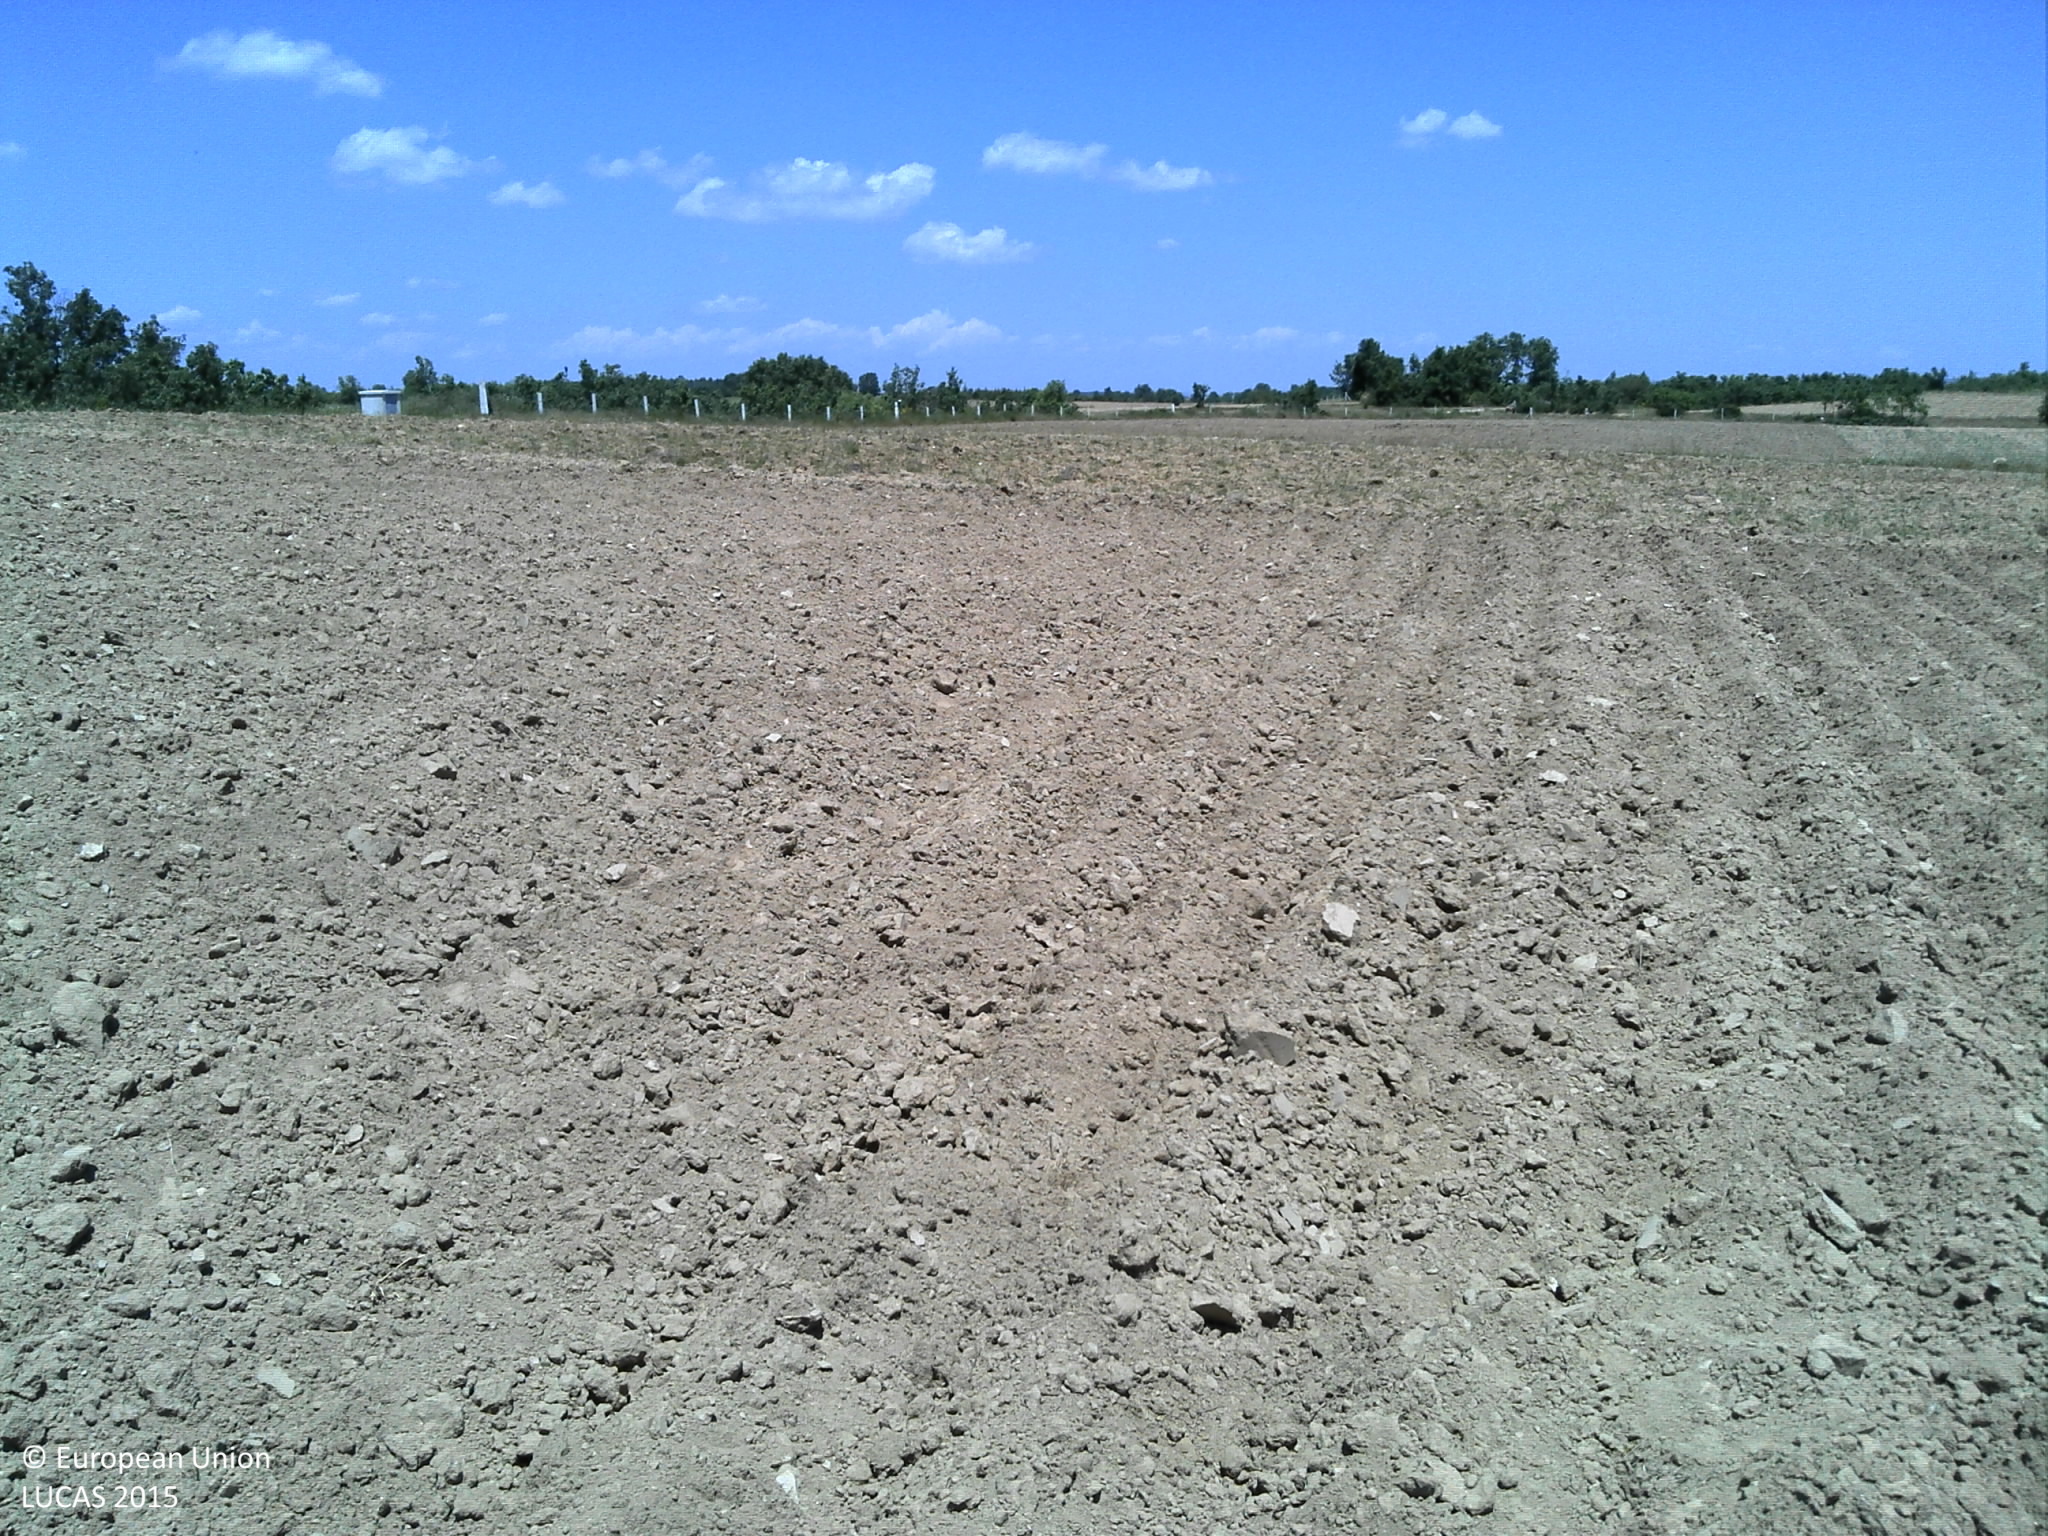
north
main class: Cropland
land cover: Oats
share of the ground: < 10 %
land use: Agriculture (excluding fallow land and kitchen gardens)
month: May
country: PT
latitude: 41.5371
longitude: -6.3411
